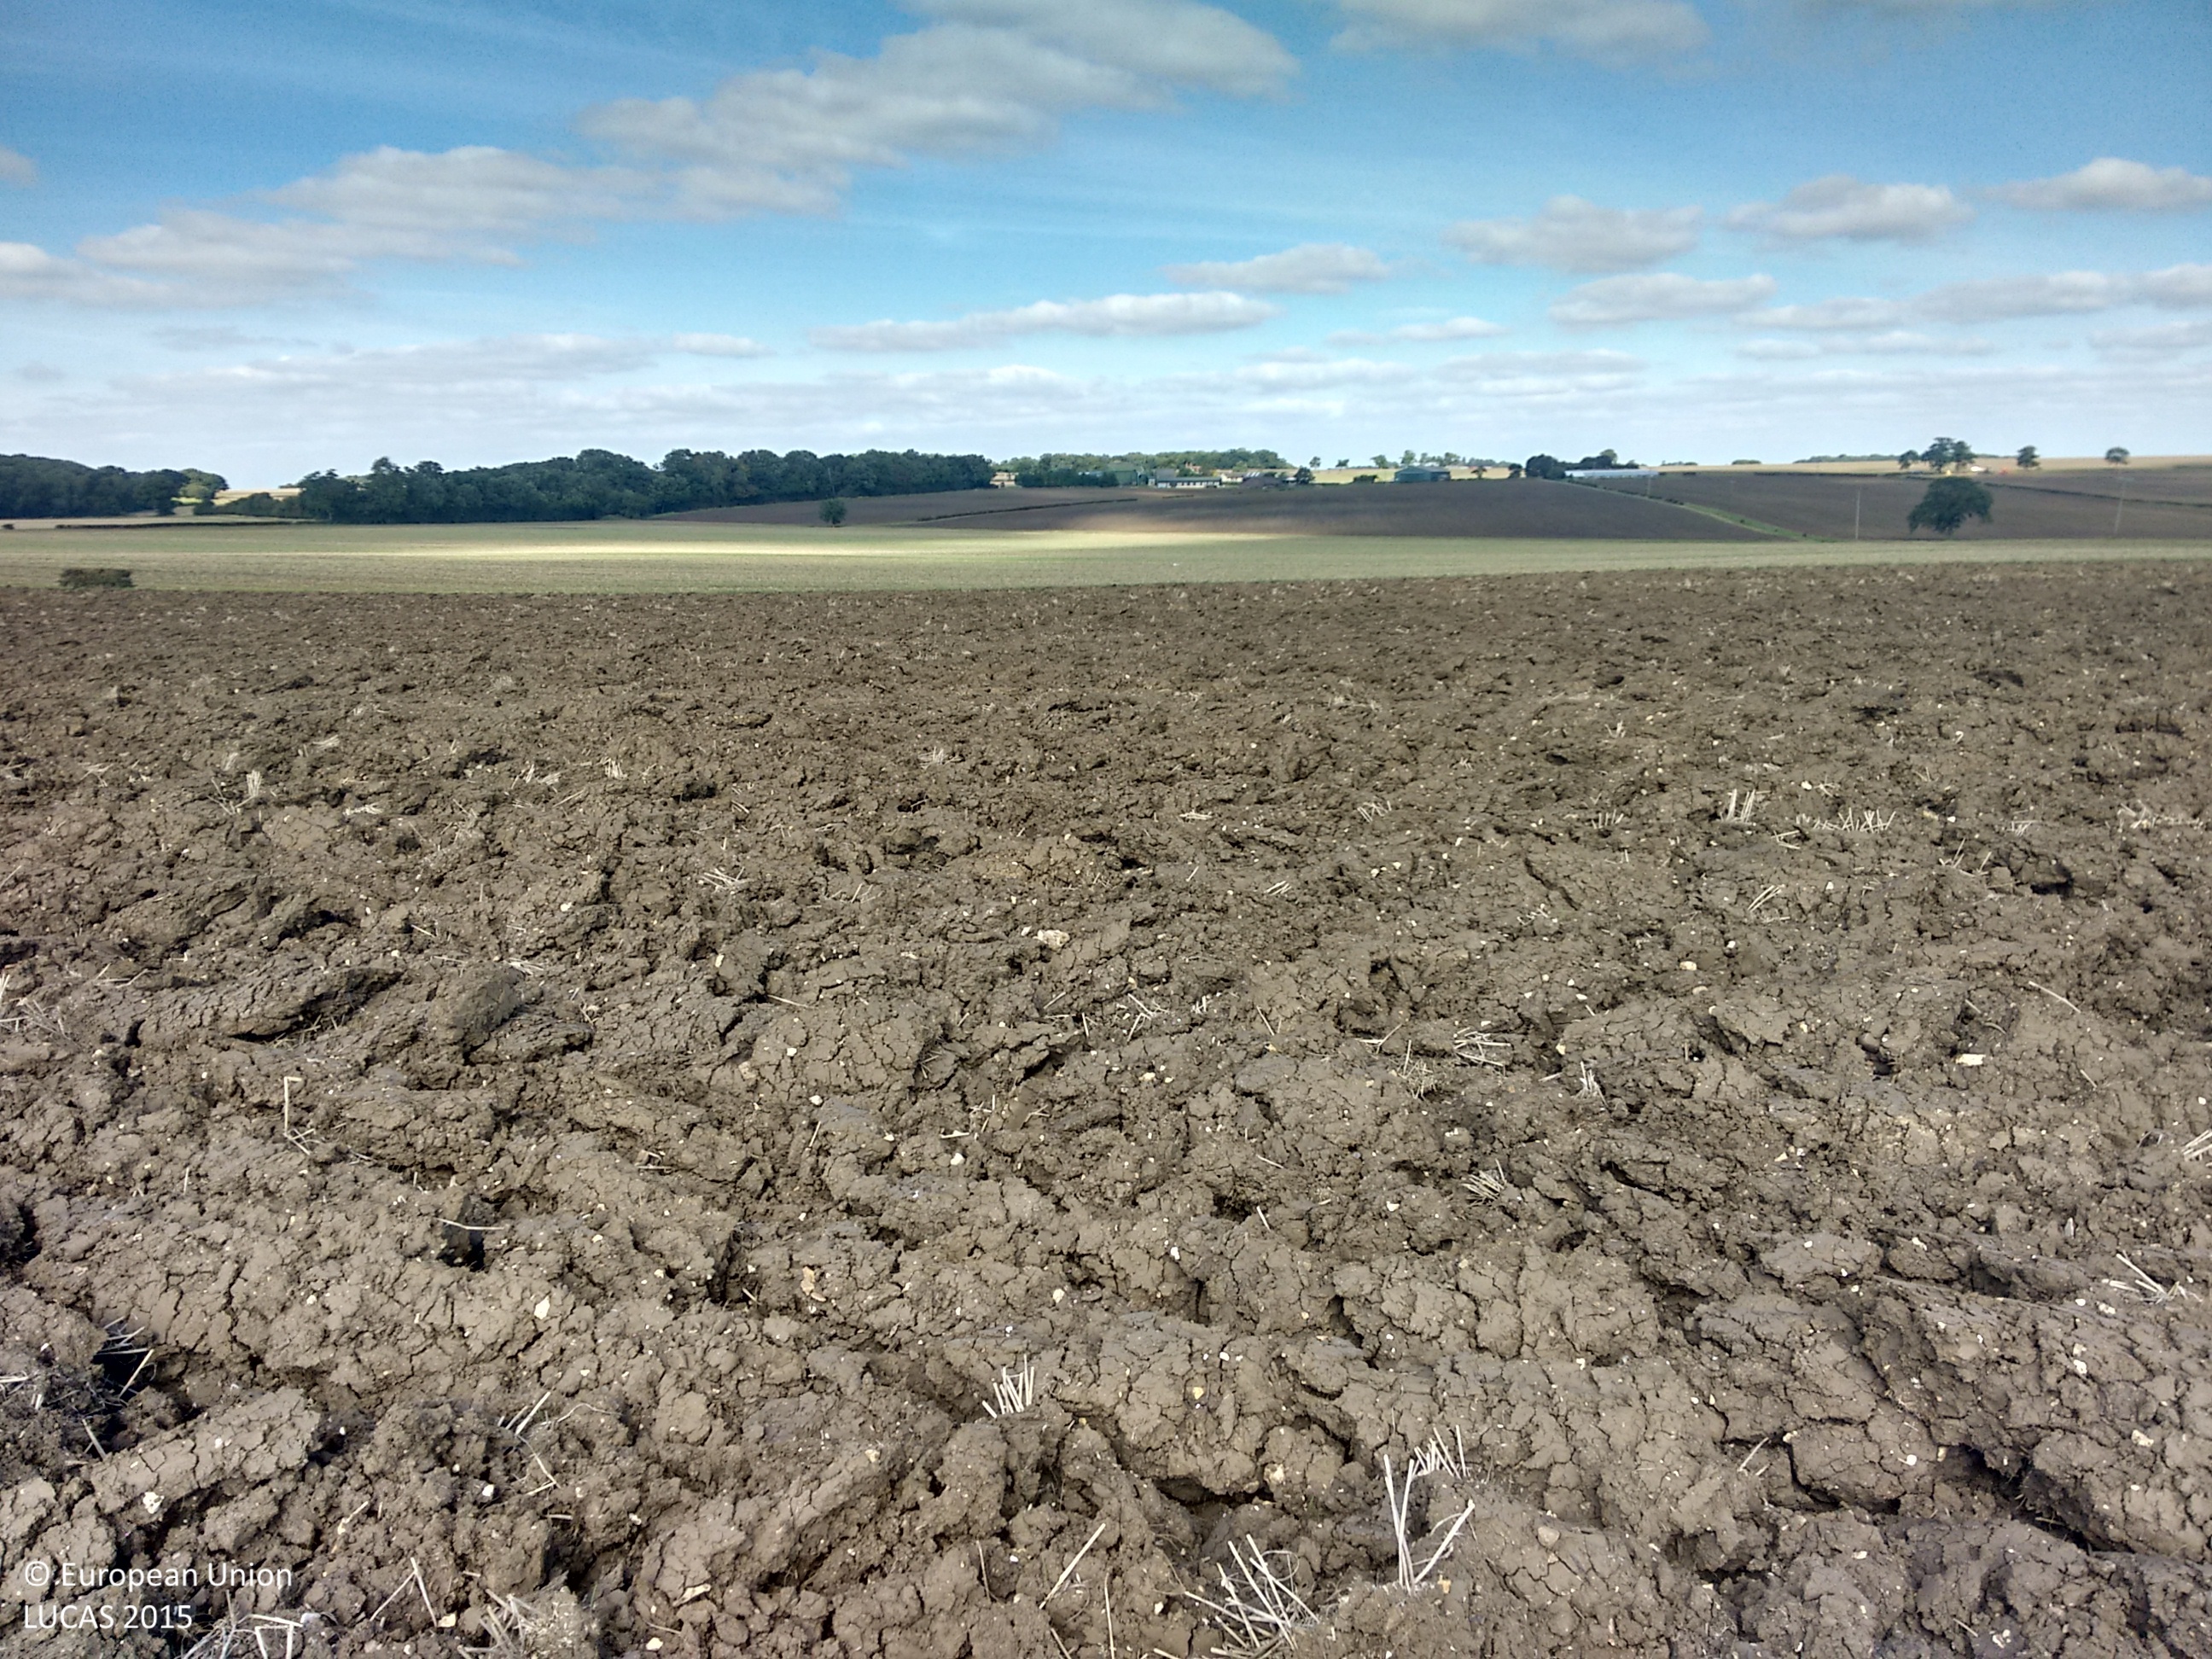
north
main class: Cropland
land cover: Common wheat
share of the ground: < 10 %
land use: Agriculture (excluding fallow land and kitchen gardens)
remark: Harvested field
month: September
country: GB
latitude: 51.9971
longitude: 0.0785
